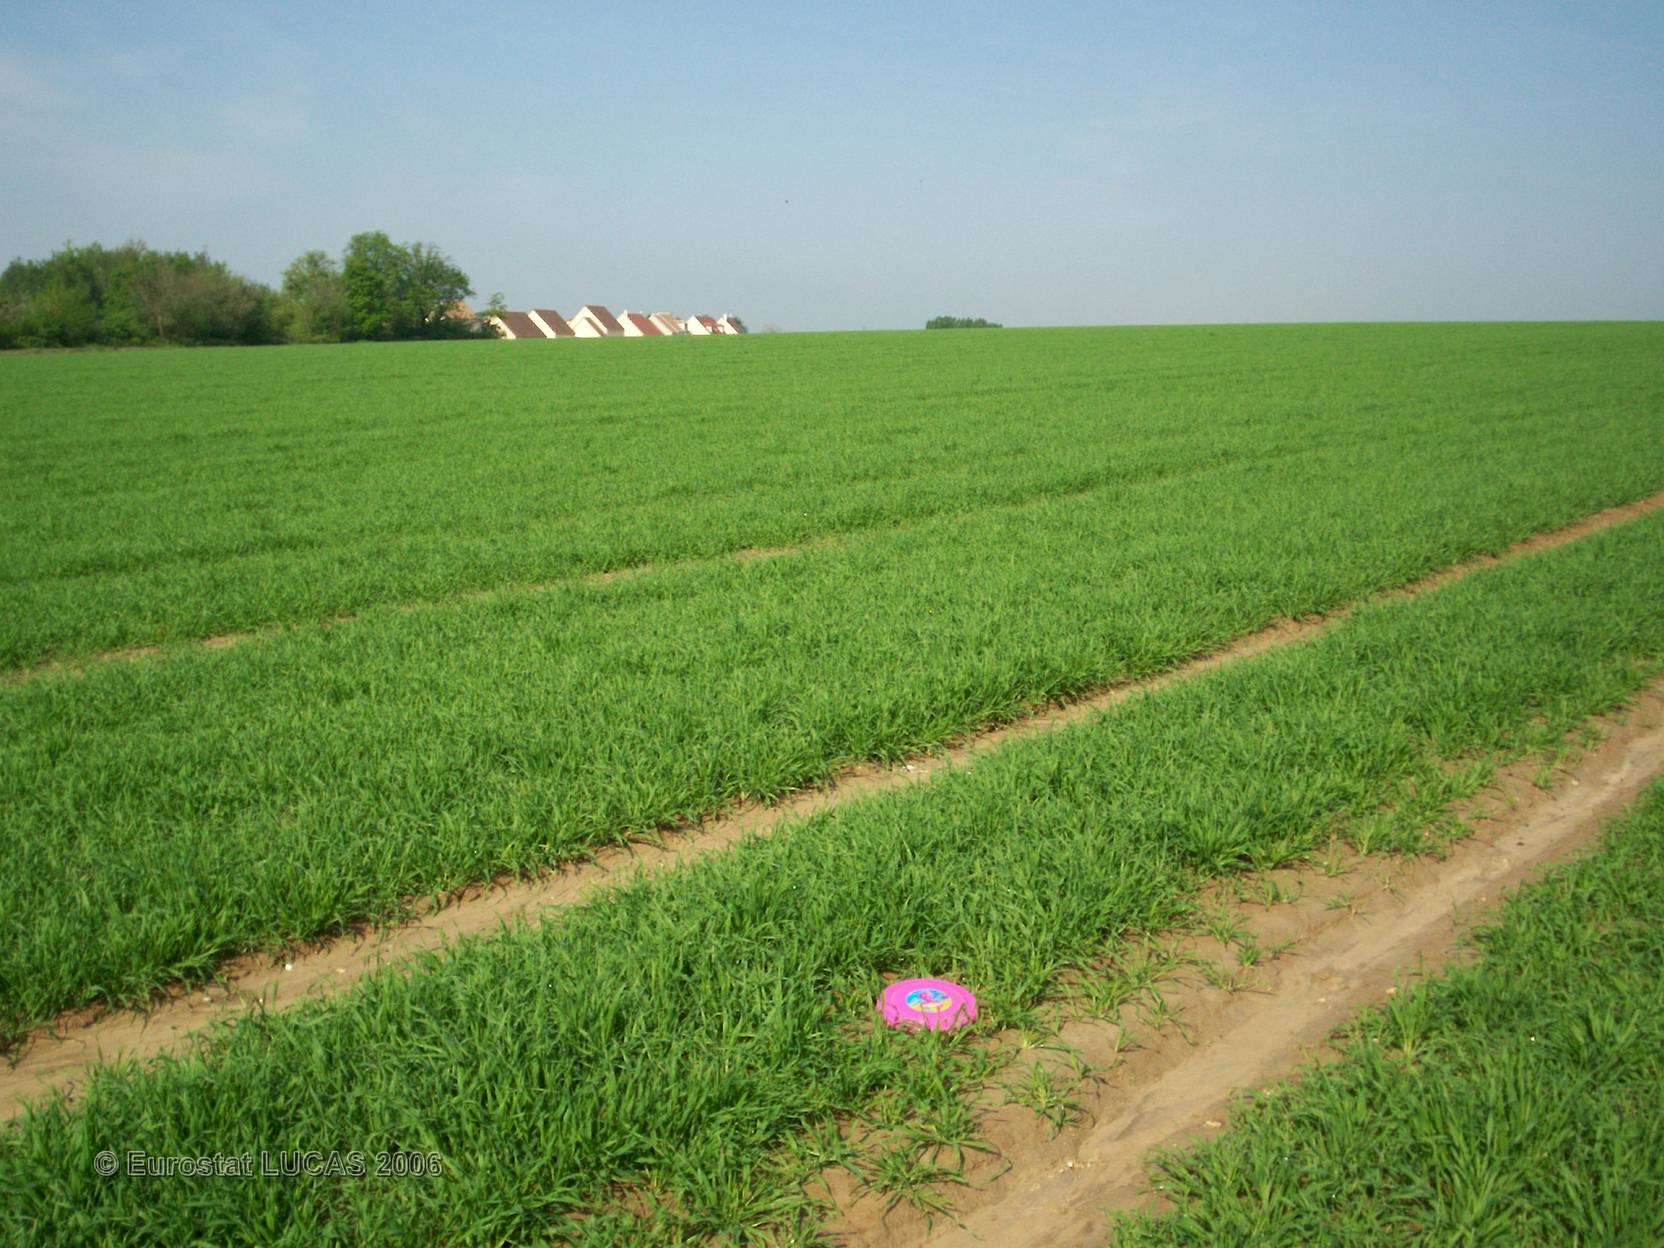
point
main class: Cropland
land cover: Barley
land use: Agriculture (excluding fallow land and kitchen gardens)
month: May
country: FR
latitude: 49.0523
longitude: 2.7789
